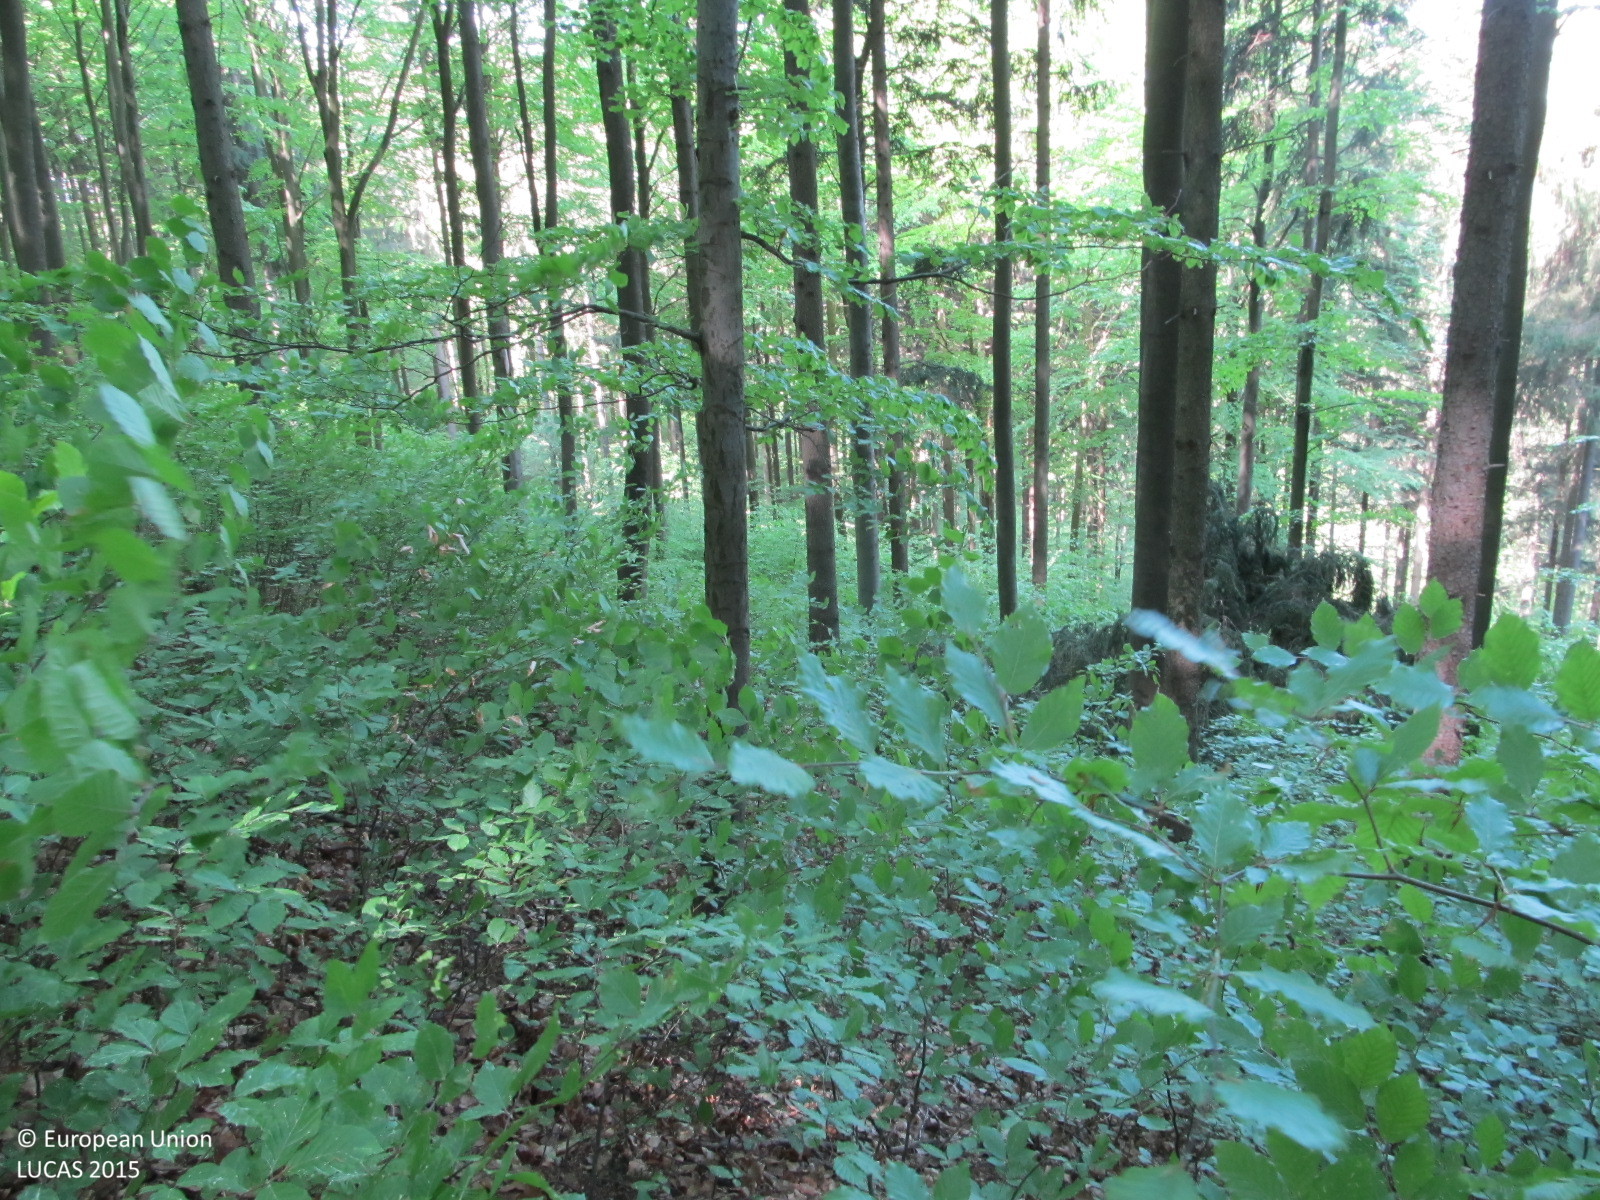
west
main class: Woodland
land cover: Broadleaved woodland
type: beech forest
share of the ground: > 75 %
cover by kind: broadleaved forest trees 60 %, coniferous forest trees 20 %, shrubs 10 %, unconsolidated bare surface 10 %
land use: Forestry
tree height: > 5 m
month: May
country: AT
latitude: 48.6081
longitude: 15.5229
